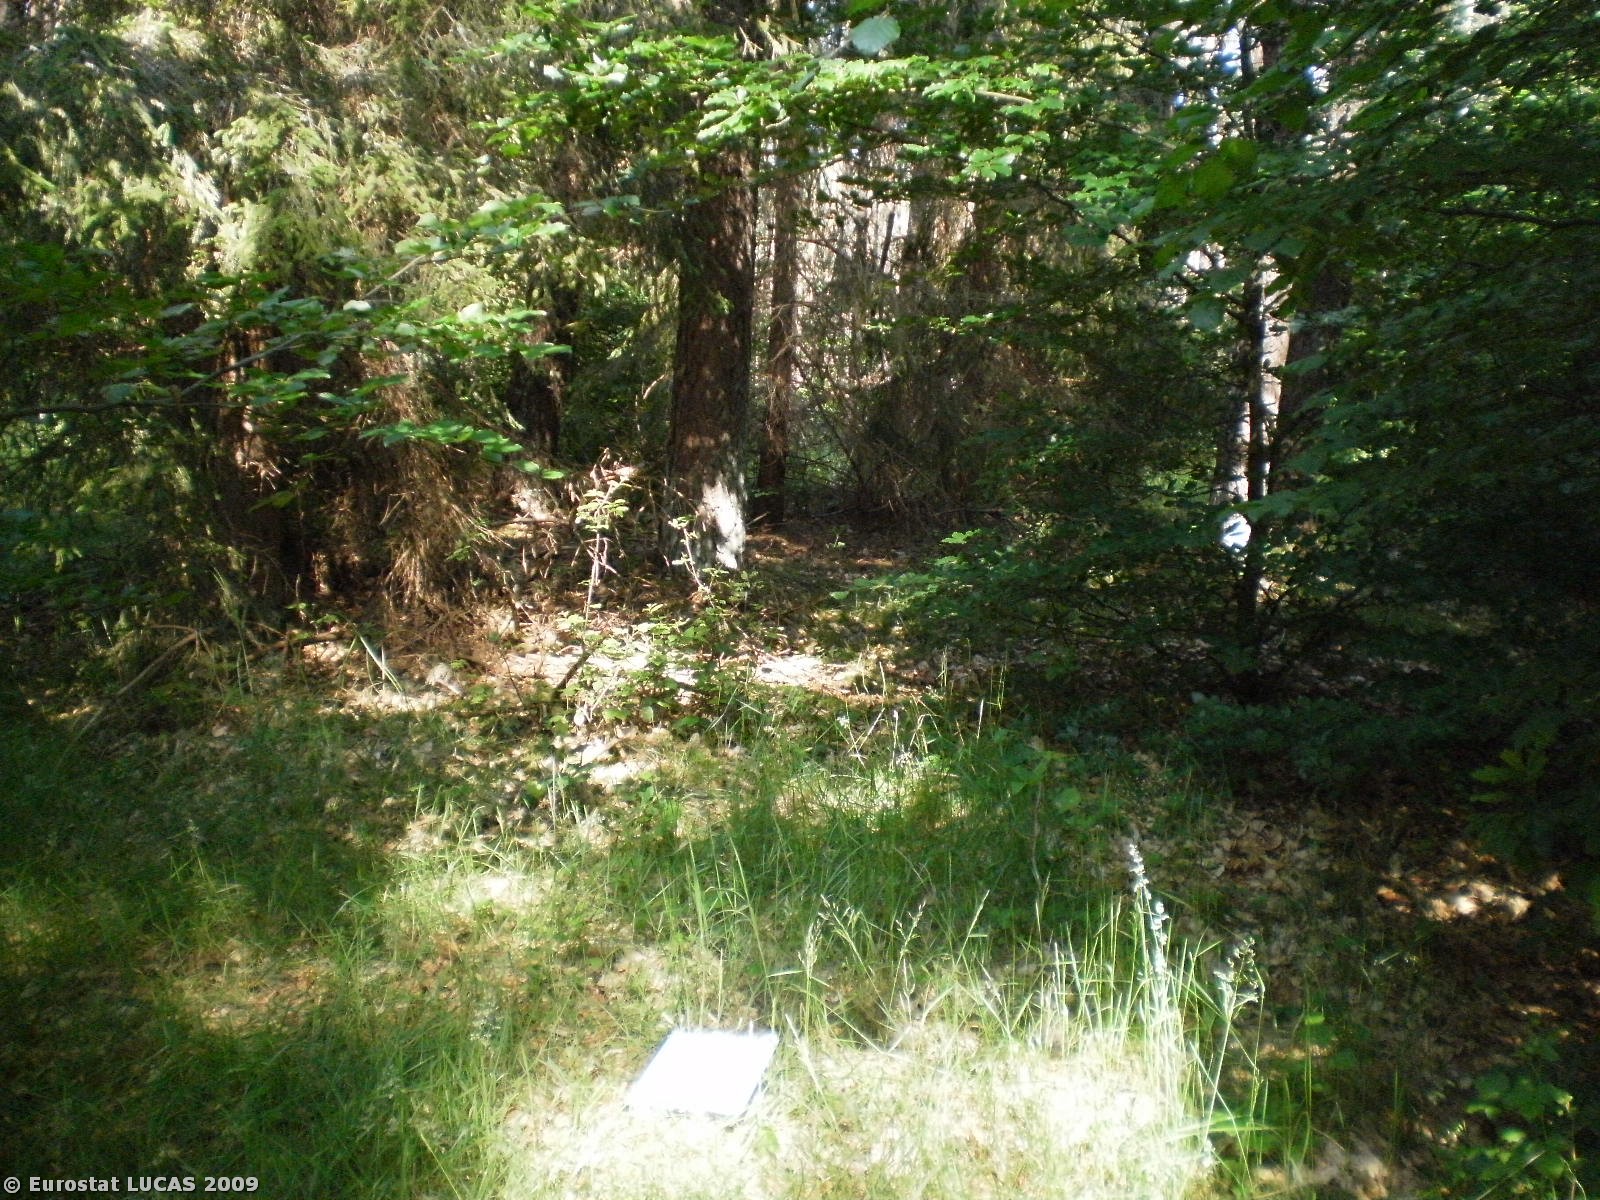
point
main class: Woodland
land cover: Mixed woodland
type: hemiboreal forest and nemoral coniferous forest and mixed broadleaved-coniferous forest
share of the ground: > 75 %
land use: Forestry
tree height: > 5 m
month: July
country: PL
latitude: 54.3020
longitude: 17.2782
